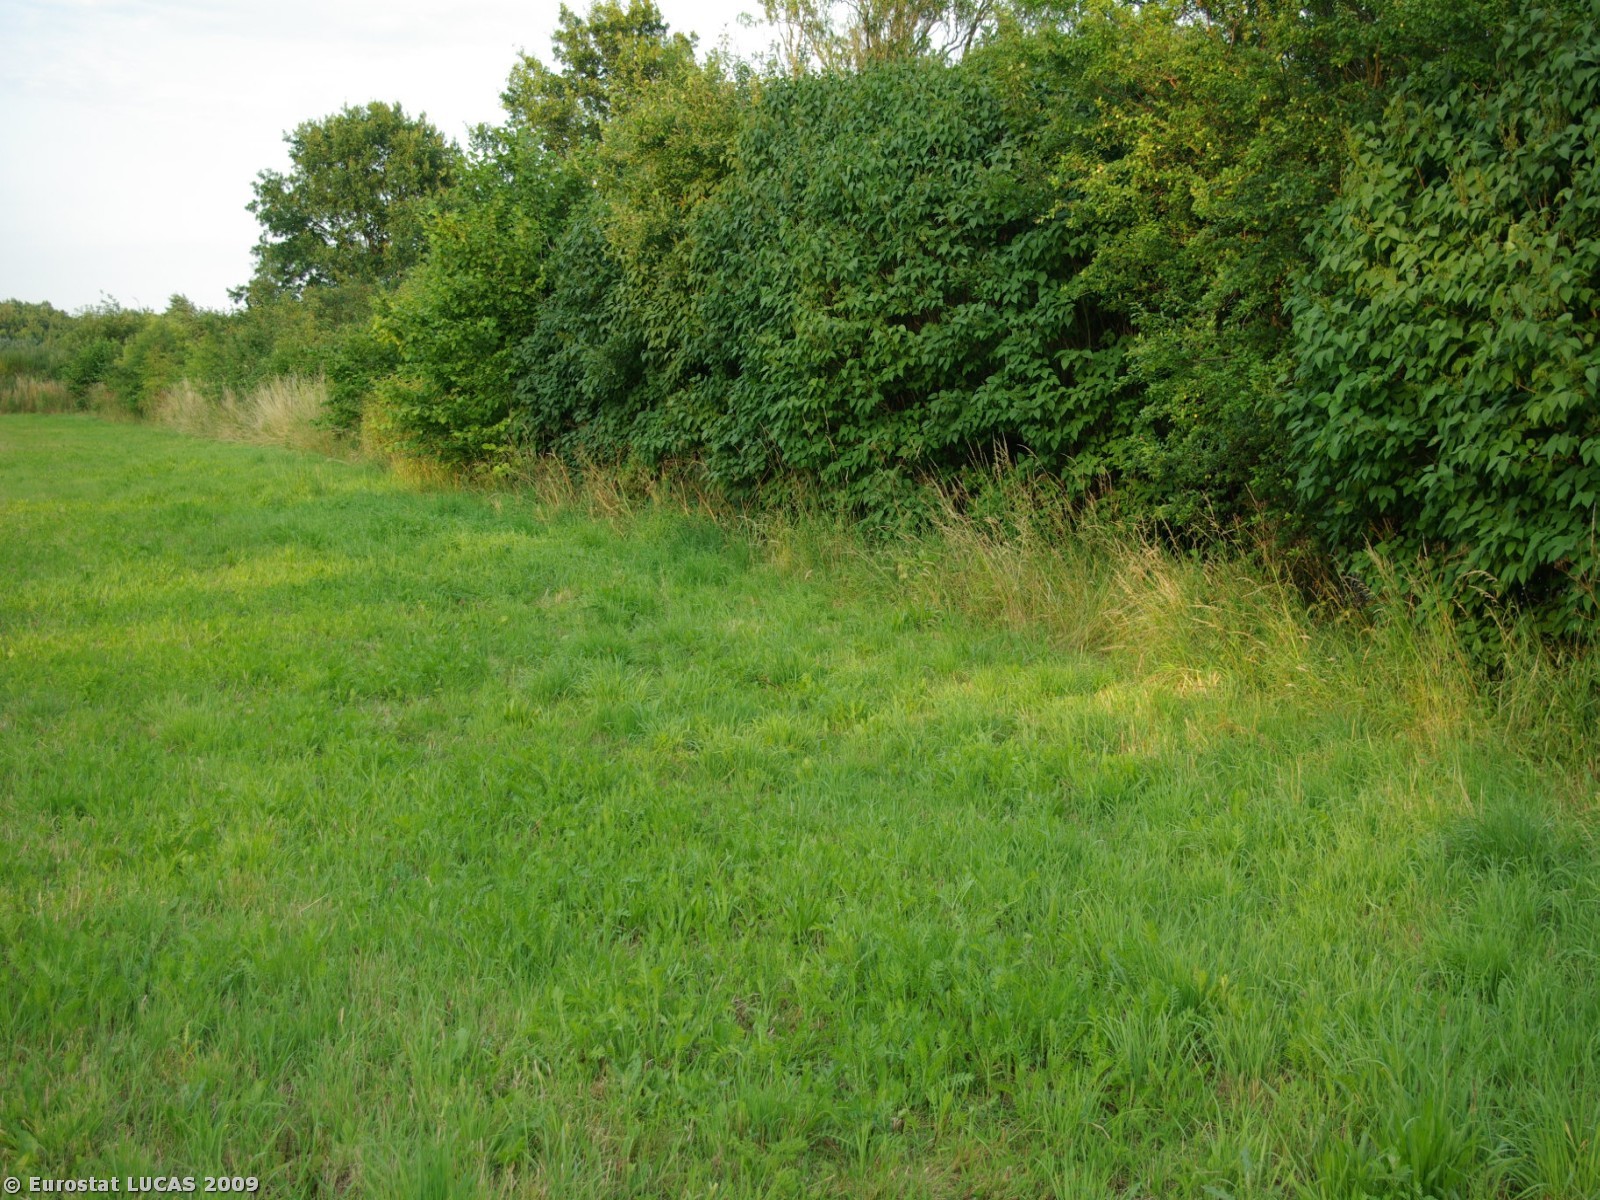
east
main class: Grassland
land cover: Grassland without tree/shrub cover
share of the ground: > 75 %
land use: Agriculture (excluding fallow land and kitchen gardens)
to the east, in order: Grassland without tree/shrub cover; Broadleaved woodland; Spontaneously vegetated surfaces; Artificial constructions in urban areas; Spontaneously vegetated surfaces; Broadleaved woodland; Artificial constructions in urban areas; Grassland without tree/shrub cover
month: July
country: DK
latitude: 54.9294
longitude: 9.7973
